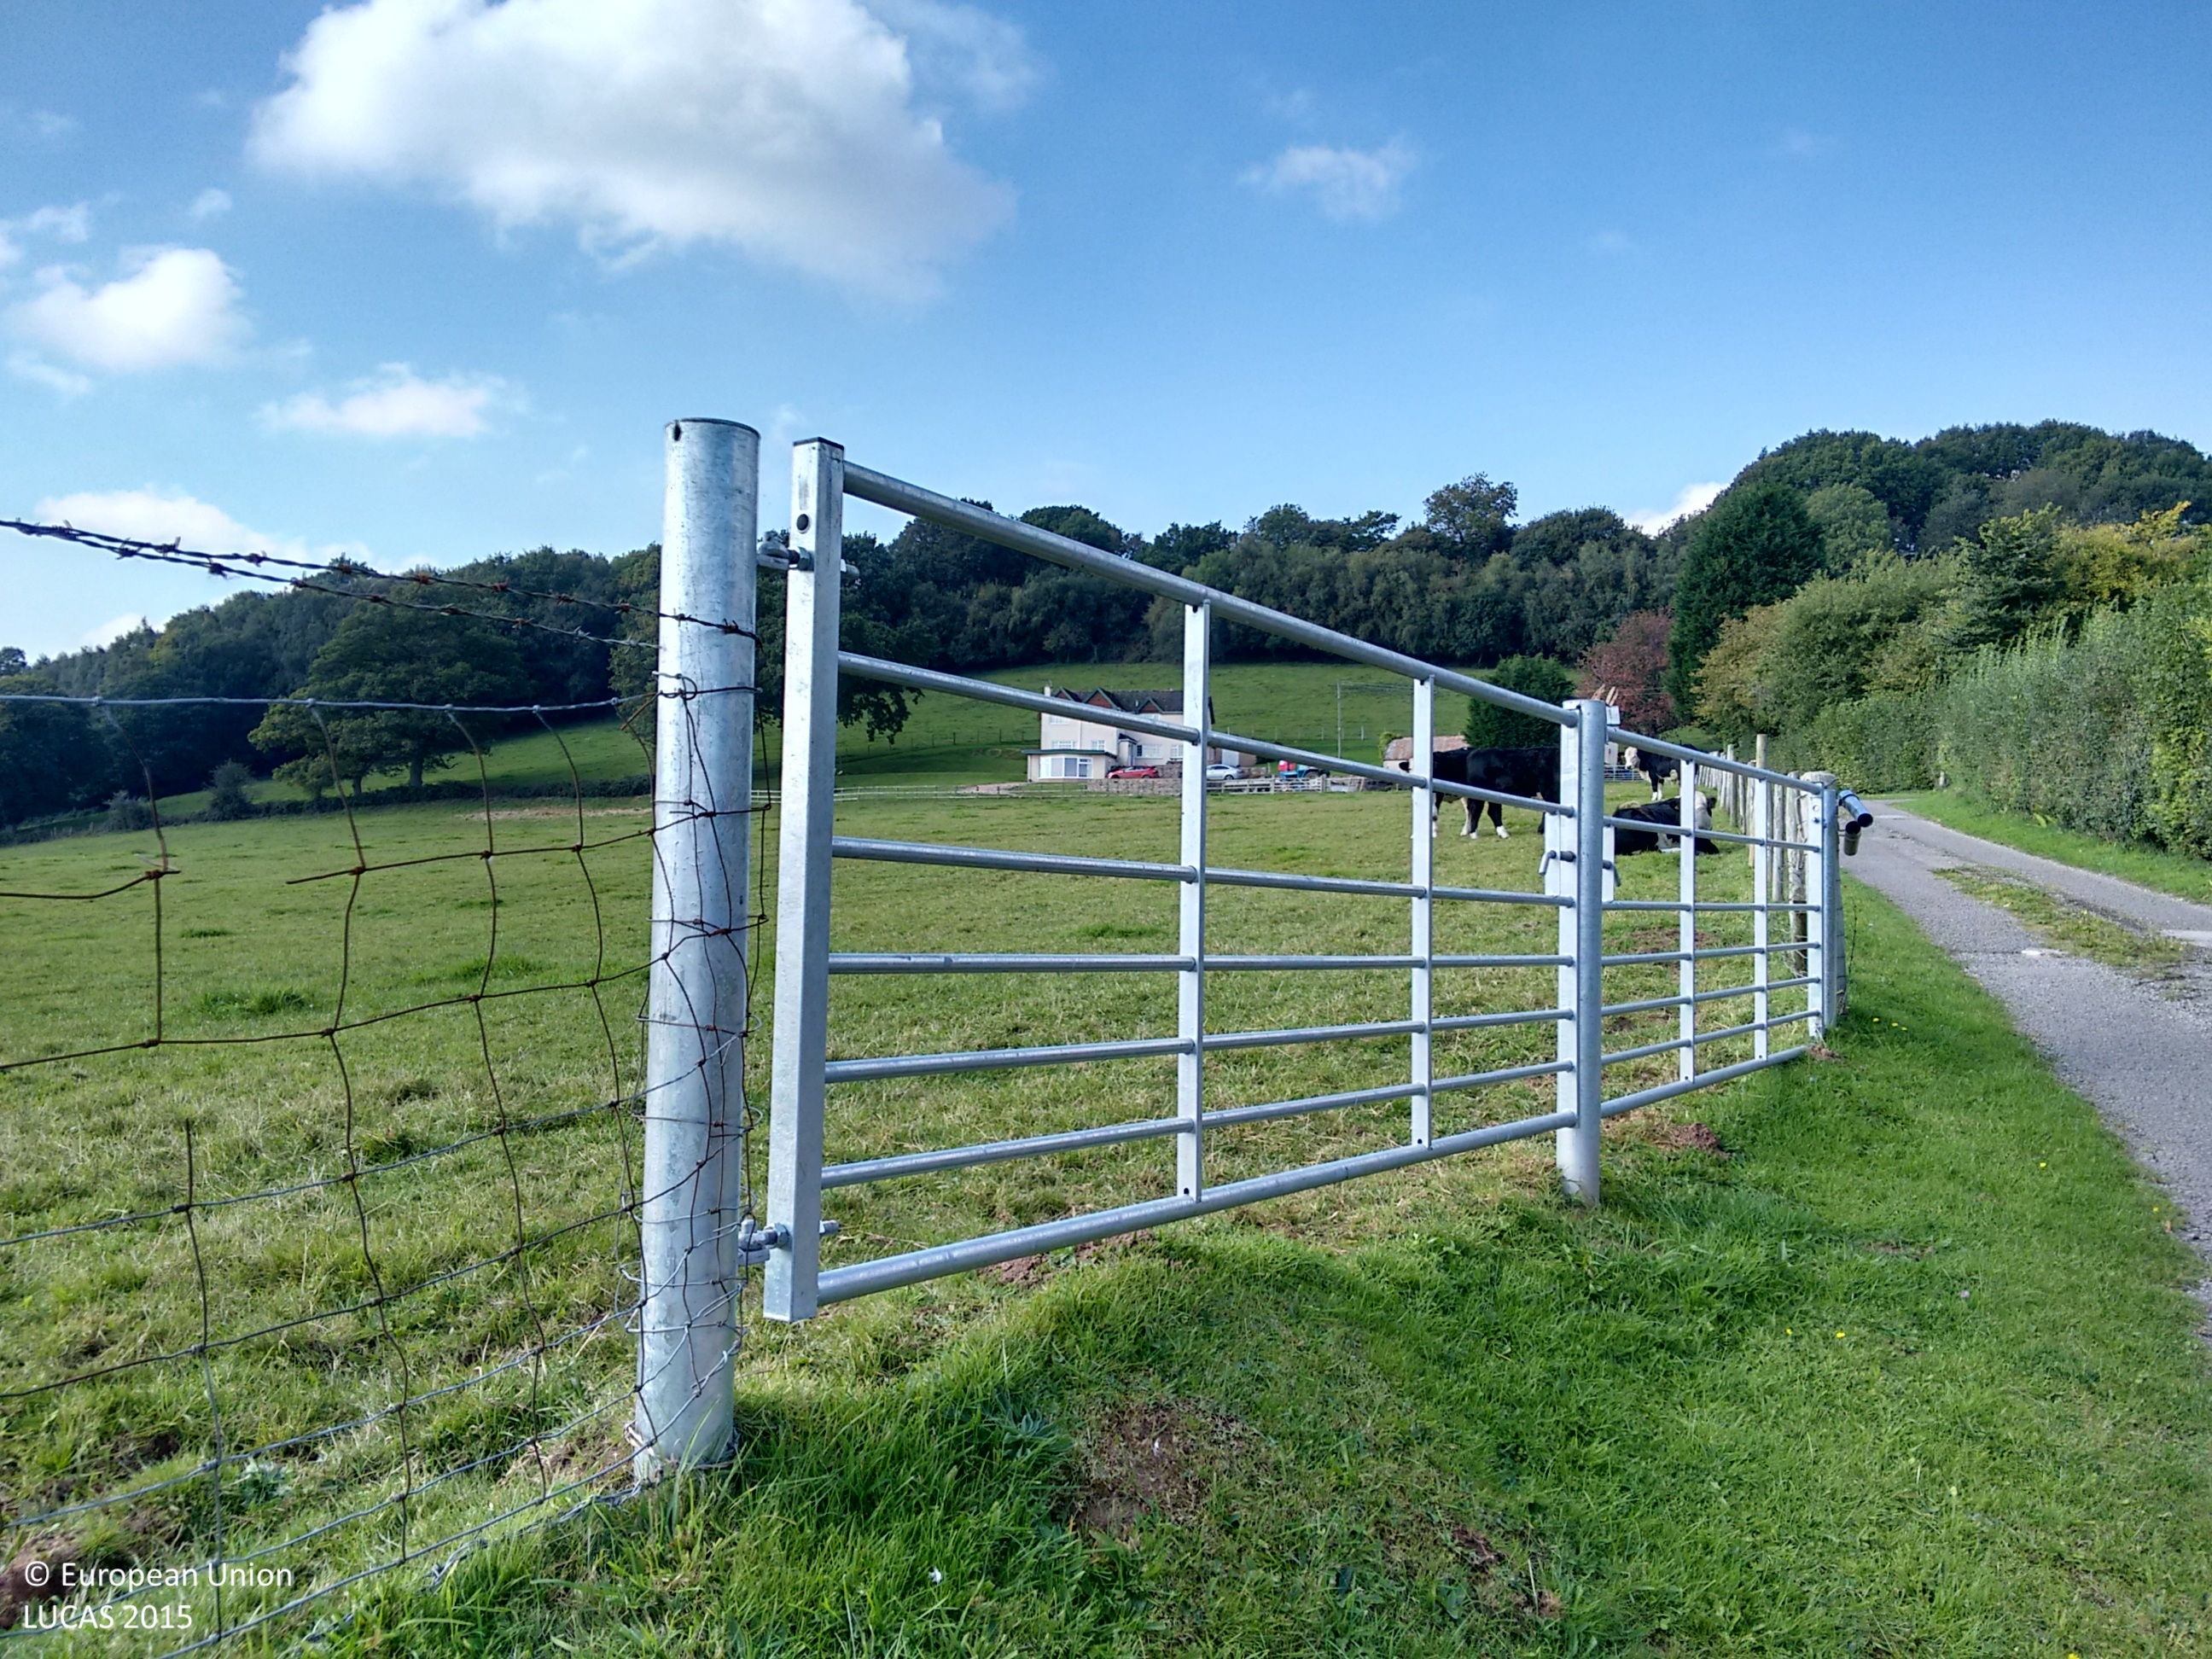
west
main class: Grassland
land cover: Grassland without tree/shrub cover
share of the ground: > 75 %
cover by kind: herbaceous plants 100 %
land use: Agriculture (excluding fallow land and kitchen gardens)
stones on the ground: < 10 %
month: October
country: GB
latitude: 51.7013
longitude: -2.6134
